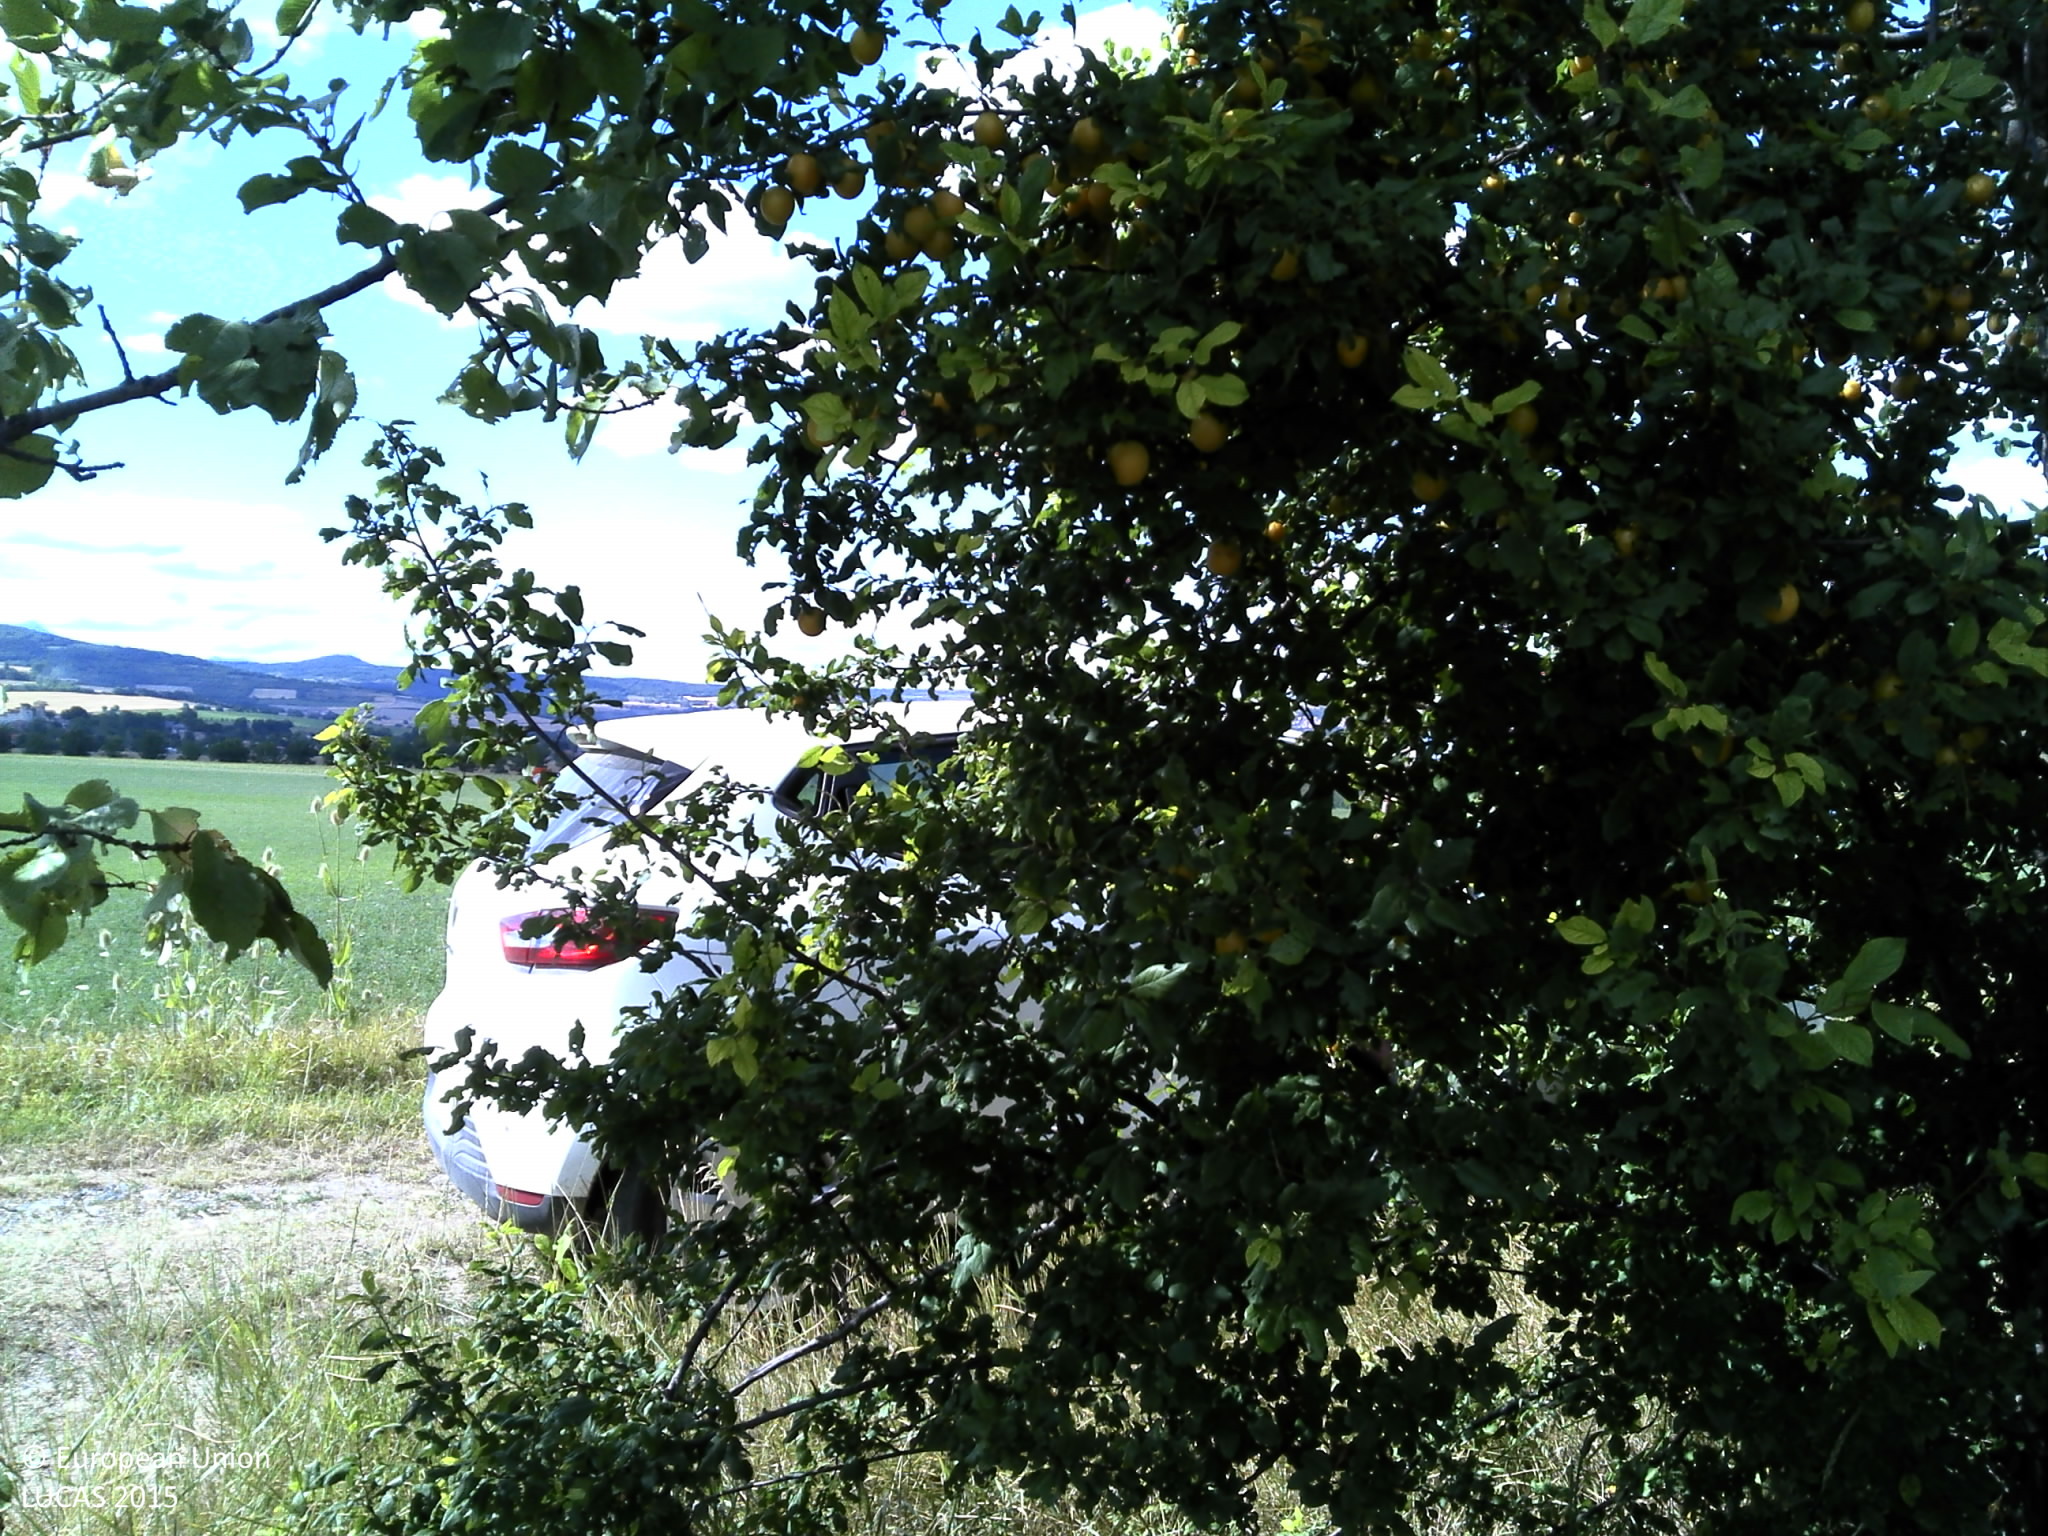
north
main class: Cropland
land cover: Maize
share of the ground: > 75 %
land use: Agriculture (excluding fallow land and kitchen gardens)
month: July
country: FR
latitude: 45.6083
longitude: 3.1662
